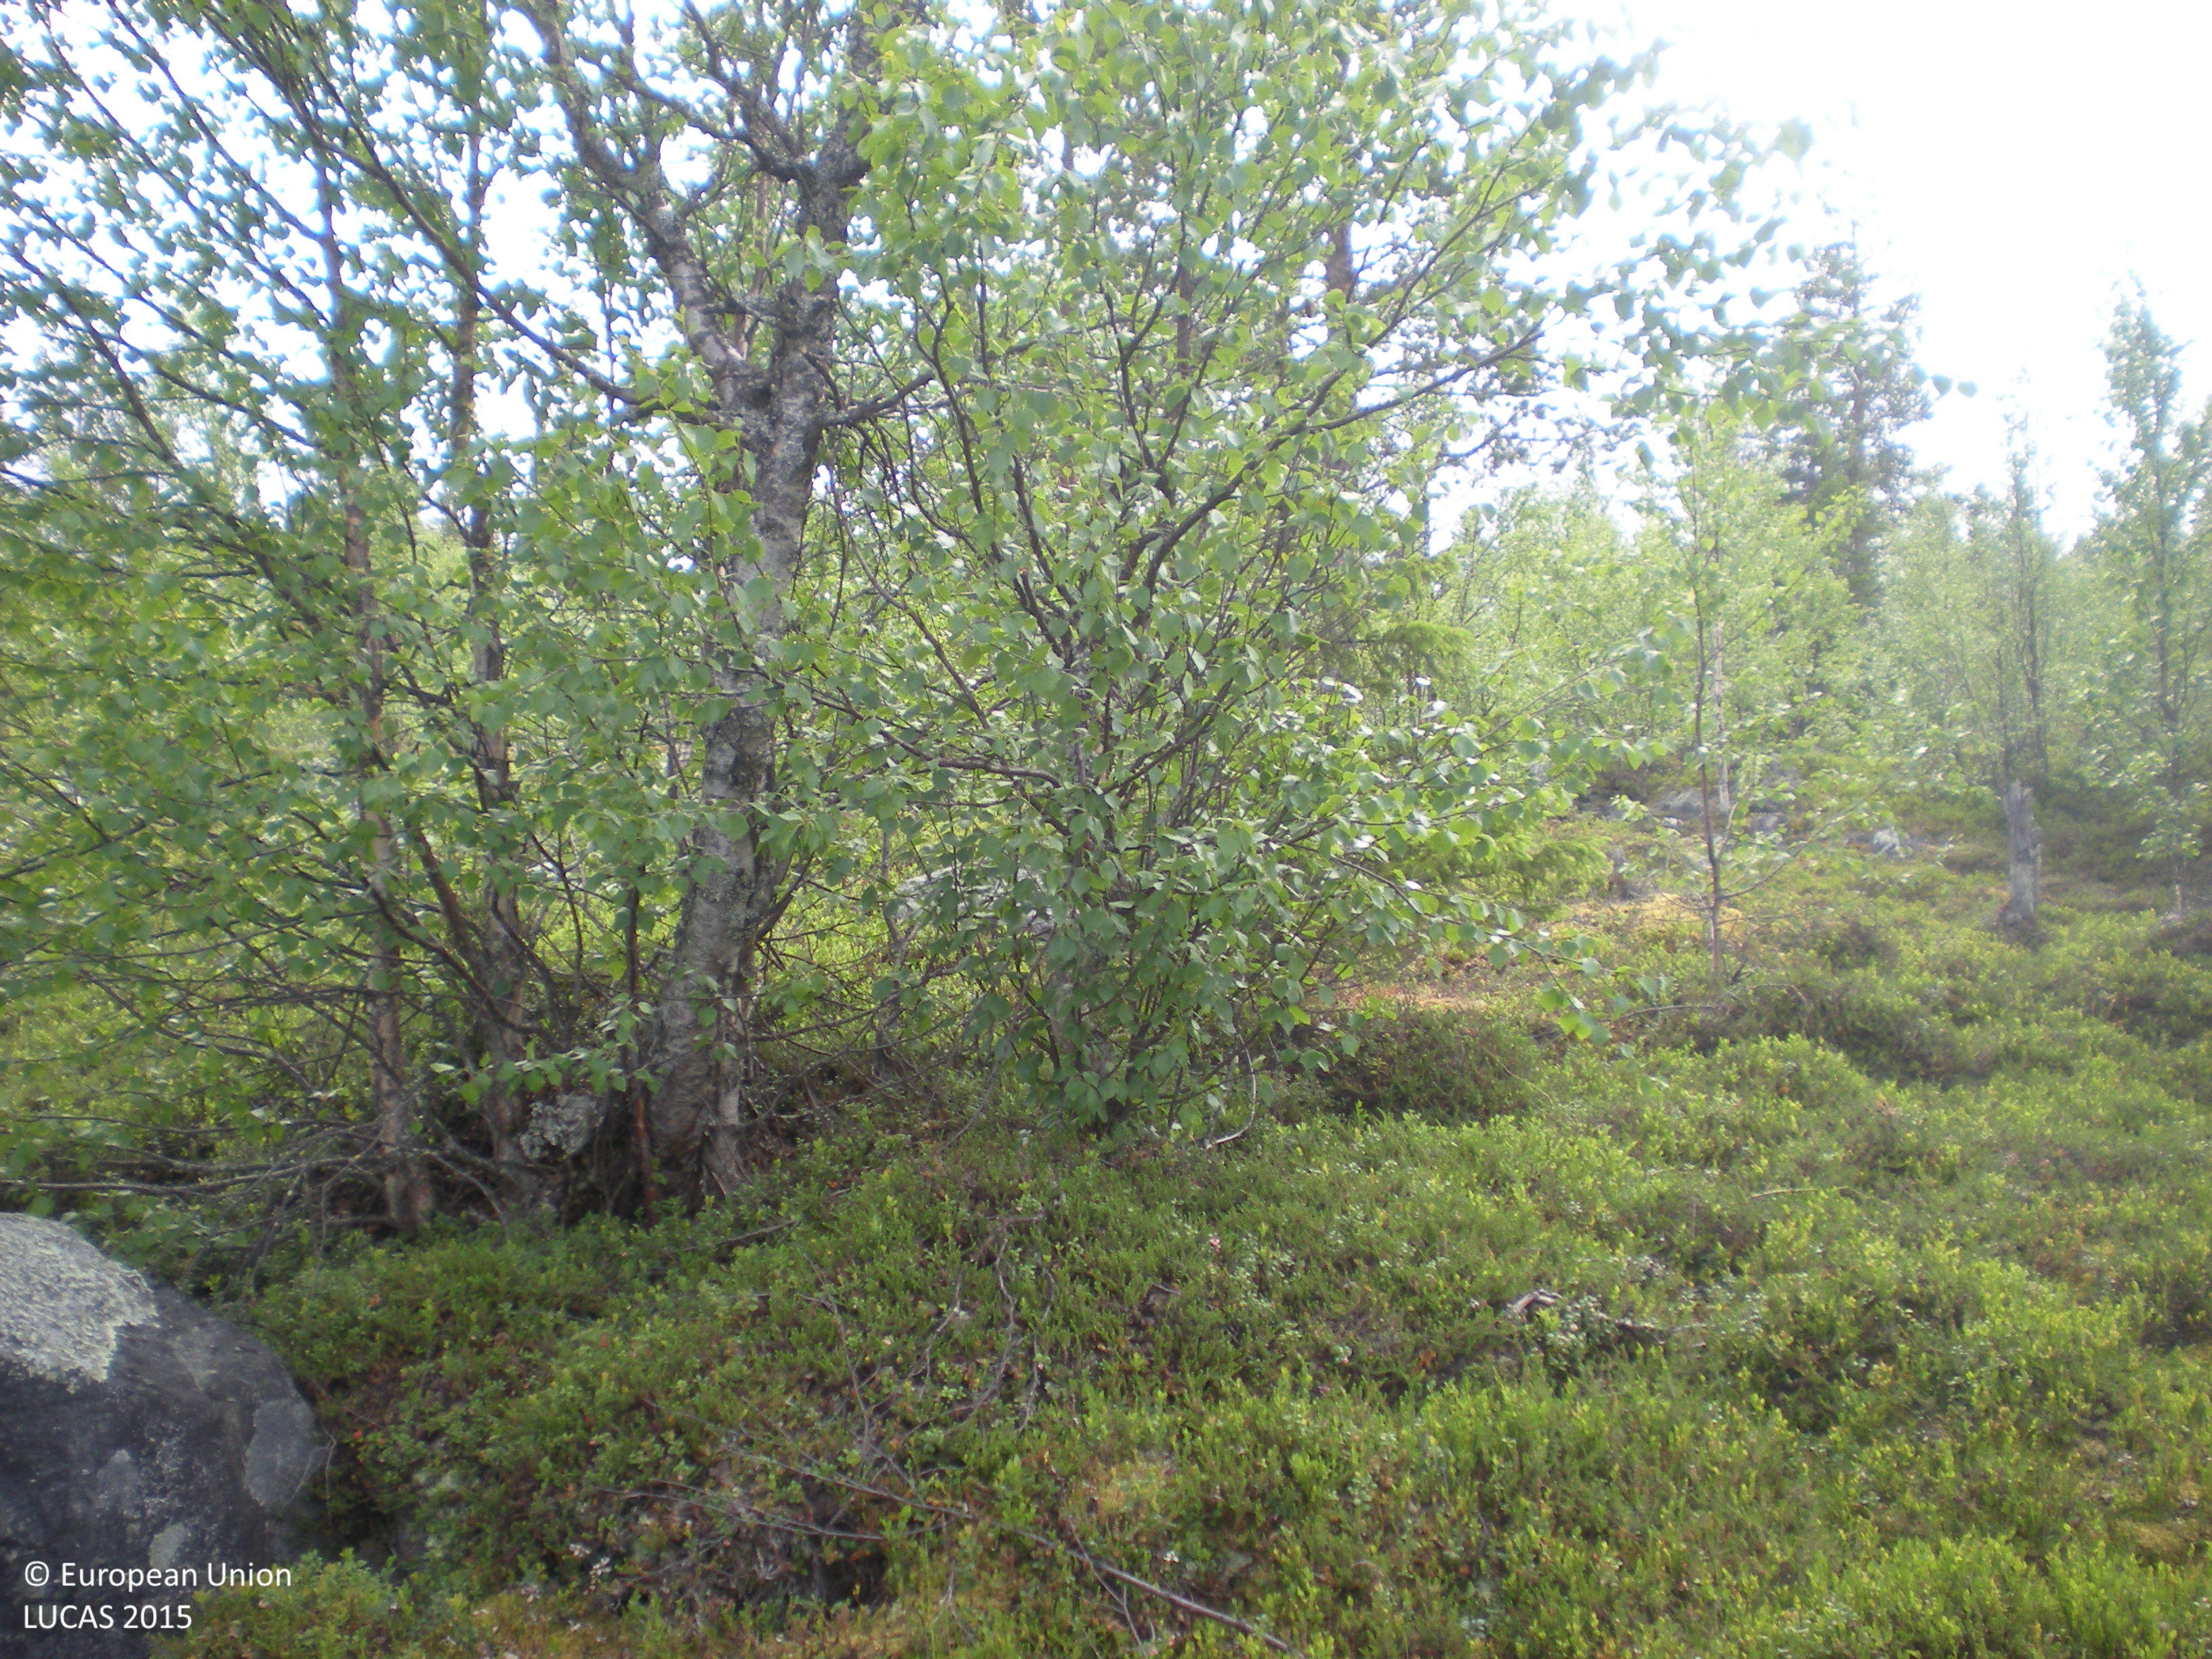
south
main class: Woodland
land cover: Spruce dominated mixed woodland
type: boreal forest
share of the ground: 25 - 50 %
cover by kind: shrubs 40 %, coniferous forest trees 25 %, broadleaved forest trees 20 %, consolidated bare surface 10 %, lichens and mosses 5 %
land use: Forestry
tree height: > 5 m
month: July
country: SE
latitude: 65.5951
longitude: 17.2256
